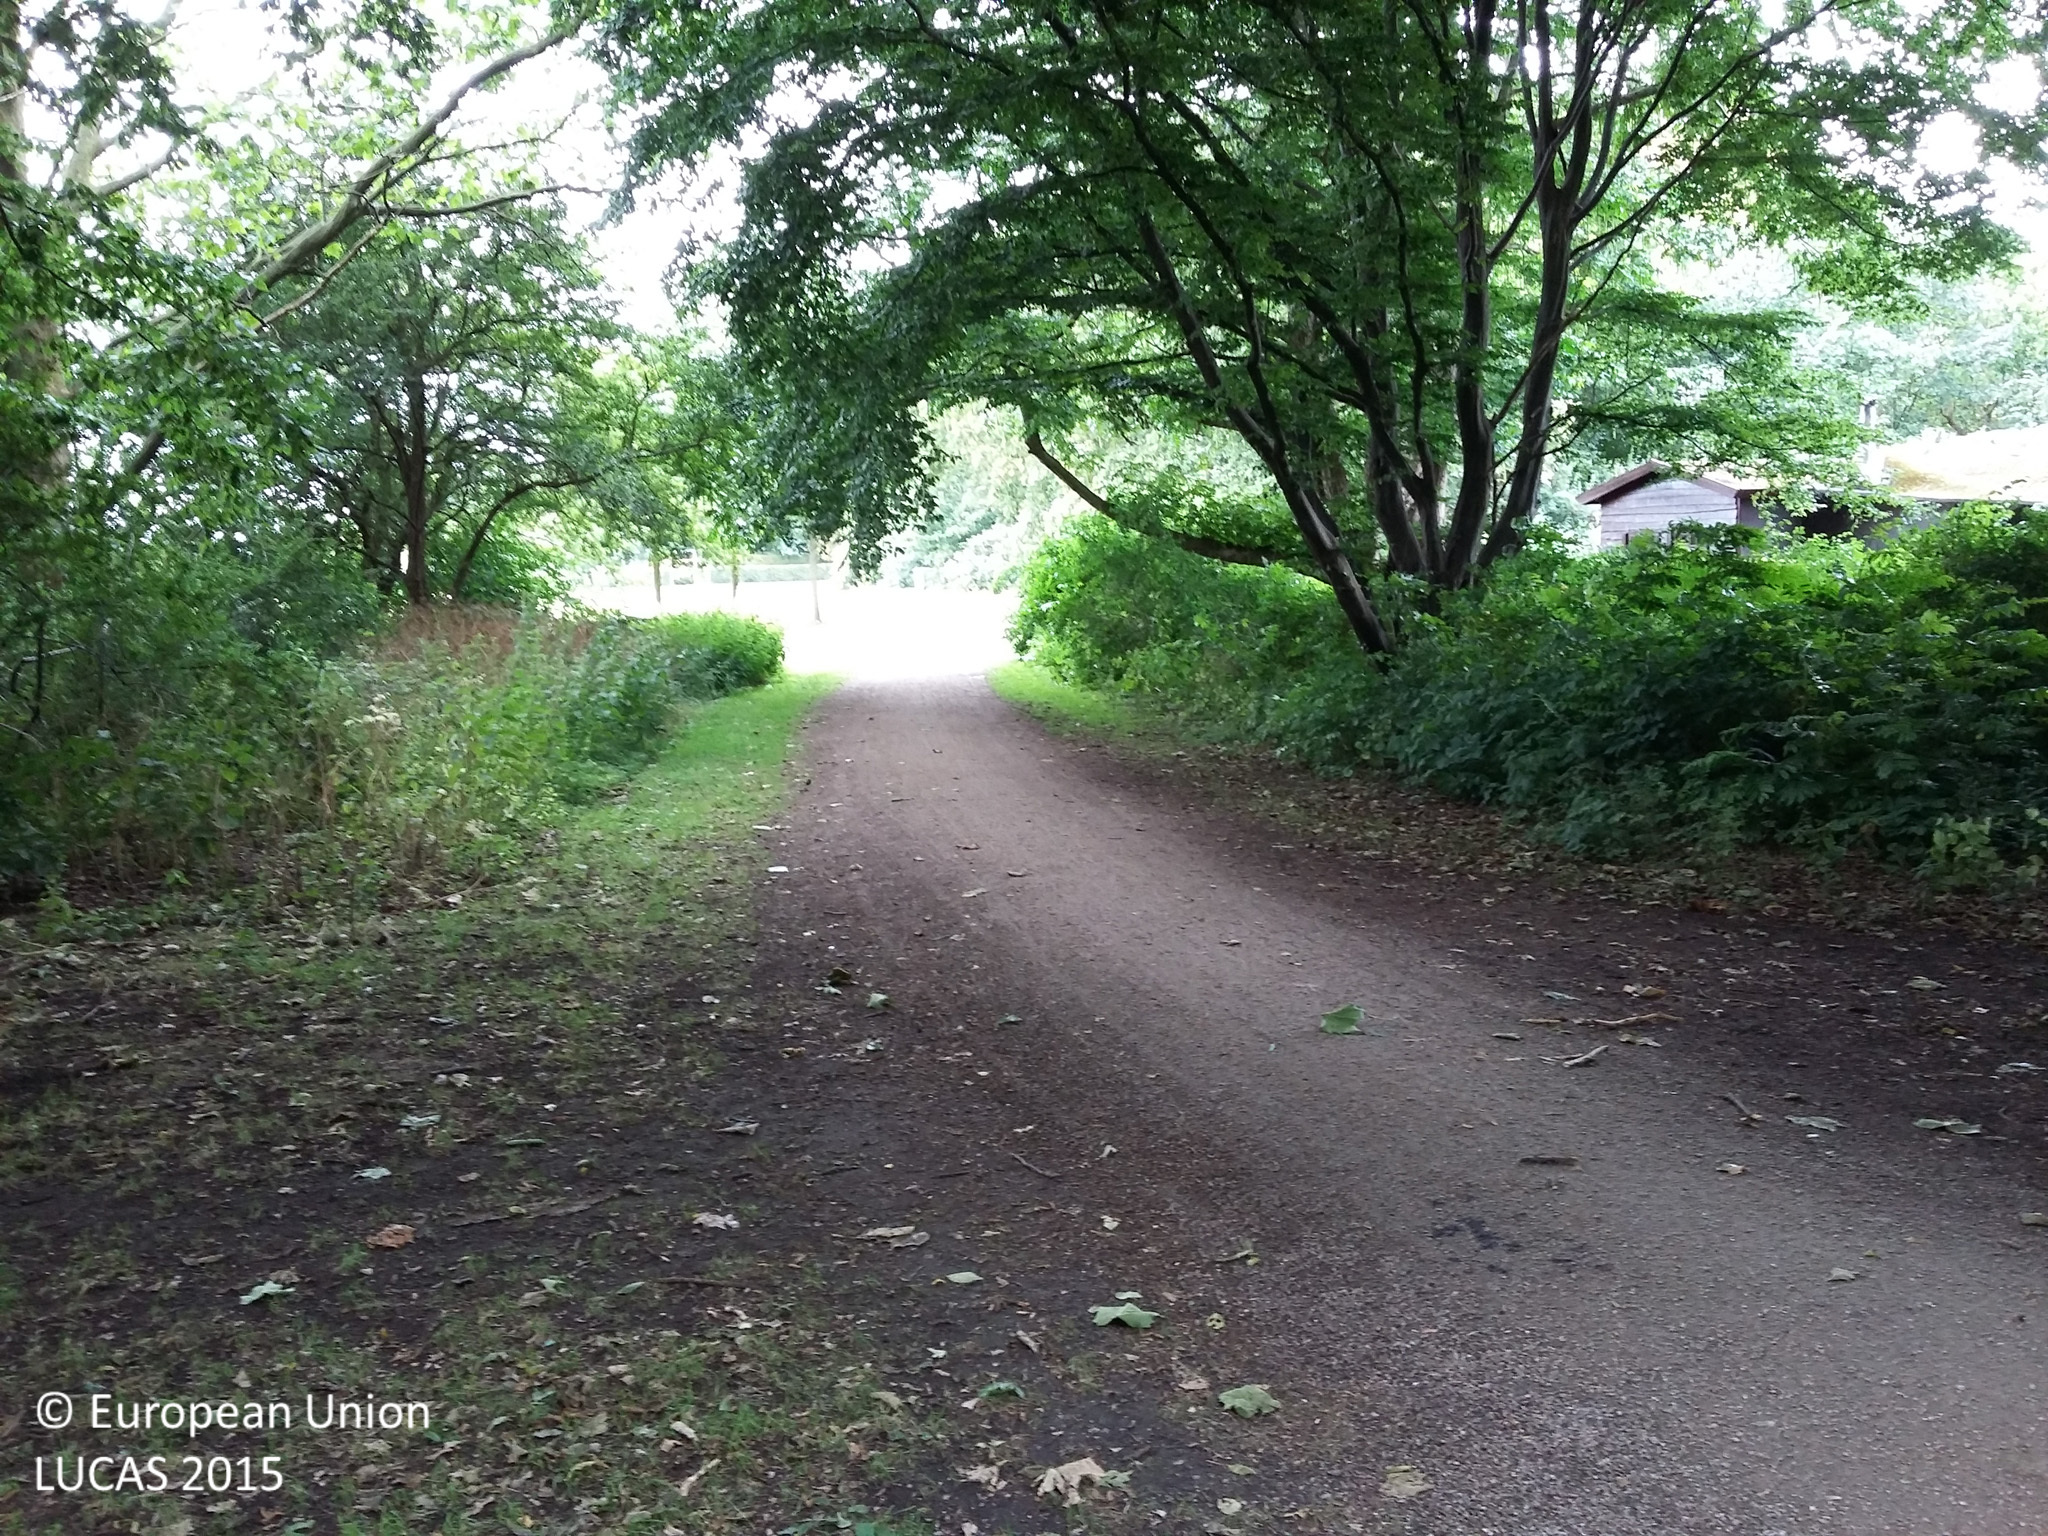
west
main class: Woodland
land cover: Broadleaved woodland
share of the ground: > 75 %
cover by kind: broadleaved forest trees 70 %, herbaceous plants 30 %
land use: Amenities, museums, leisure
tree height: > 5 m
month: July
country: DK
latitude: 55.6414
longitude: 12.5242
